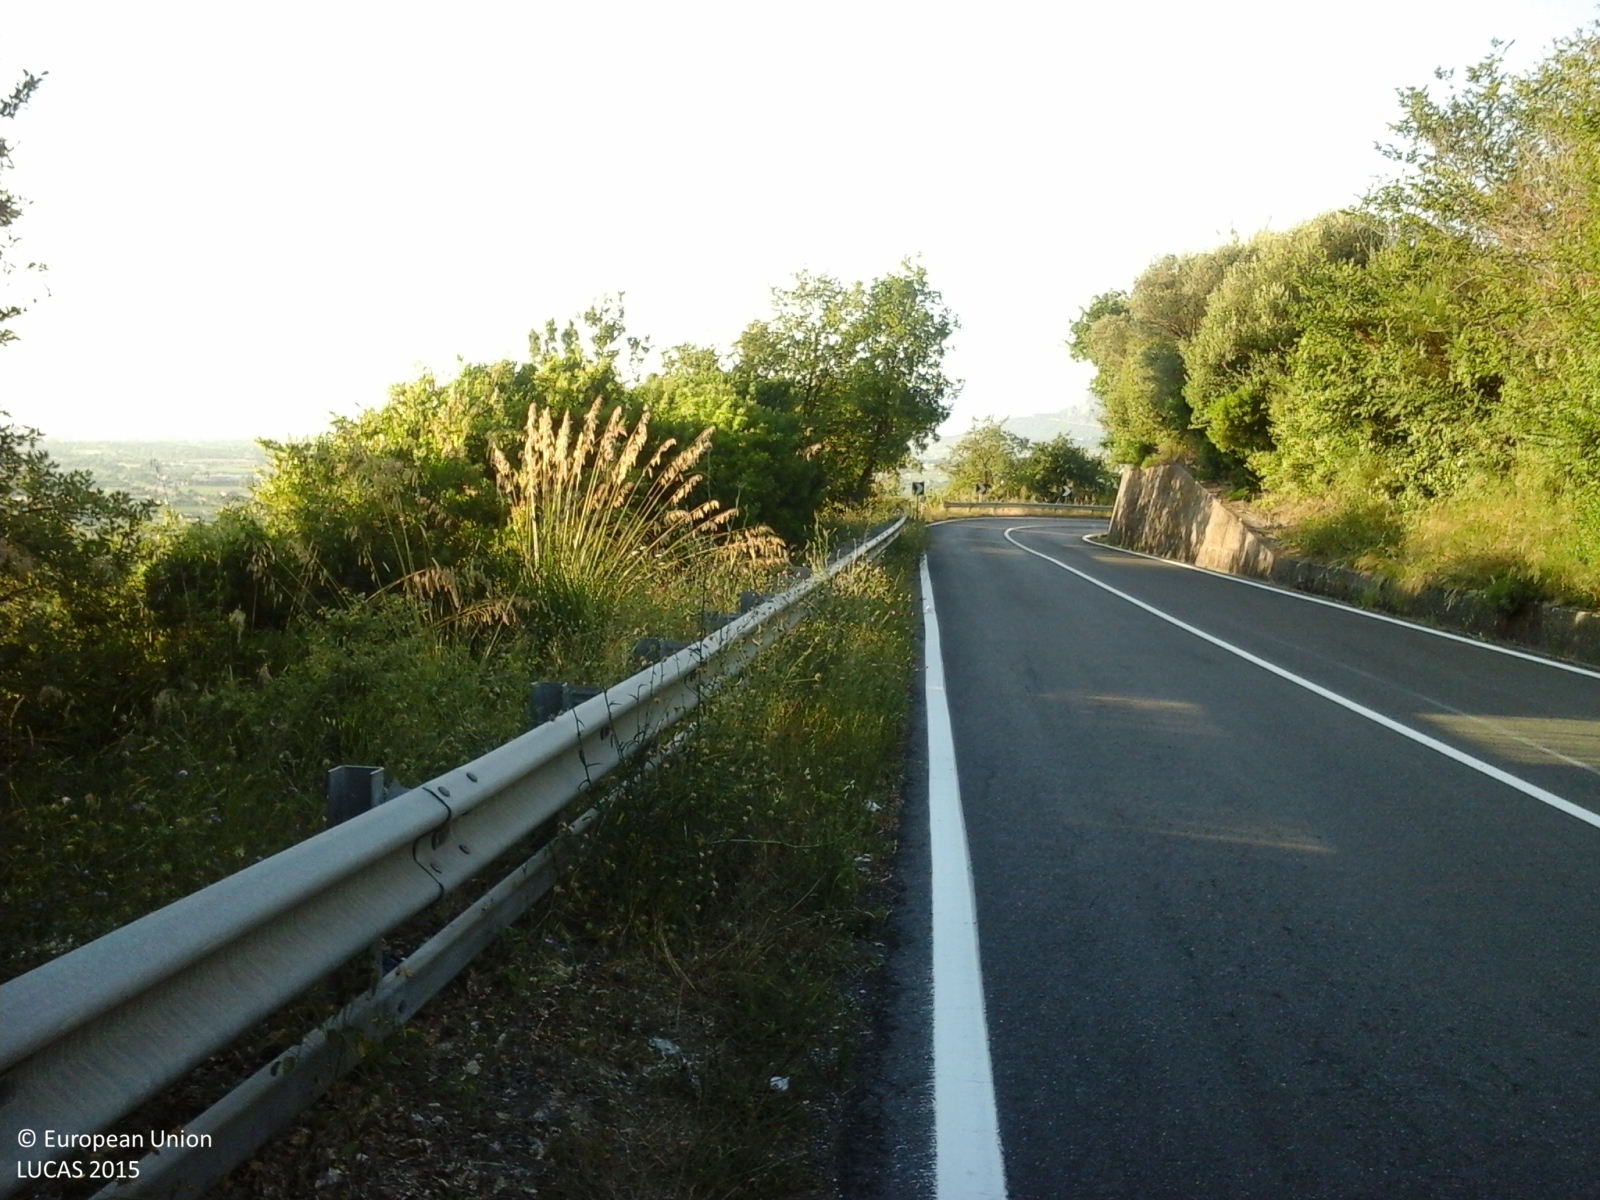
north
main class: Woodland
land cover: Broadleaved woodland
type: thermophilous deciduous forest
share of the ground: > 75 %
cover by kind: broadleaved forest trees 100 %
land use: Forestry
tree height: > 5 m
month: June
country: IT
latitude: 40.3739
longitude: 15.0307
